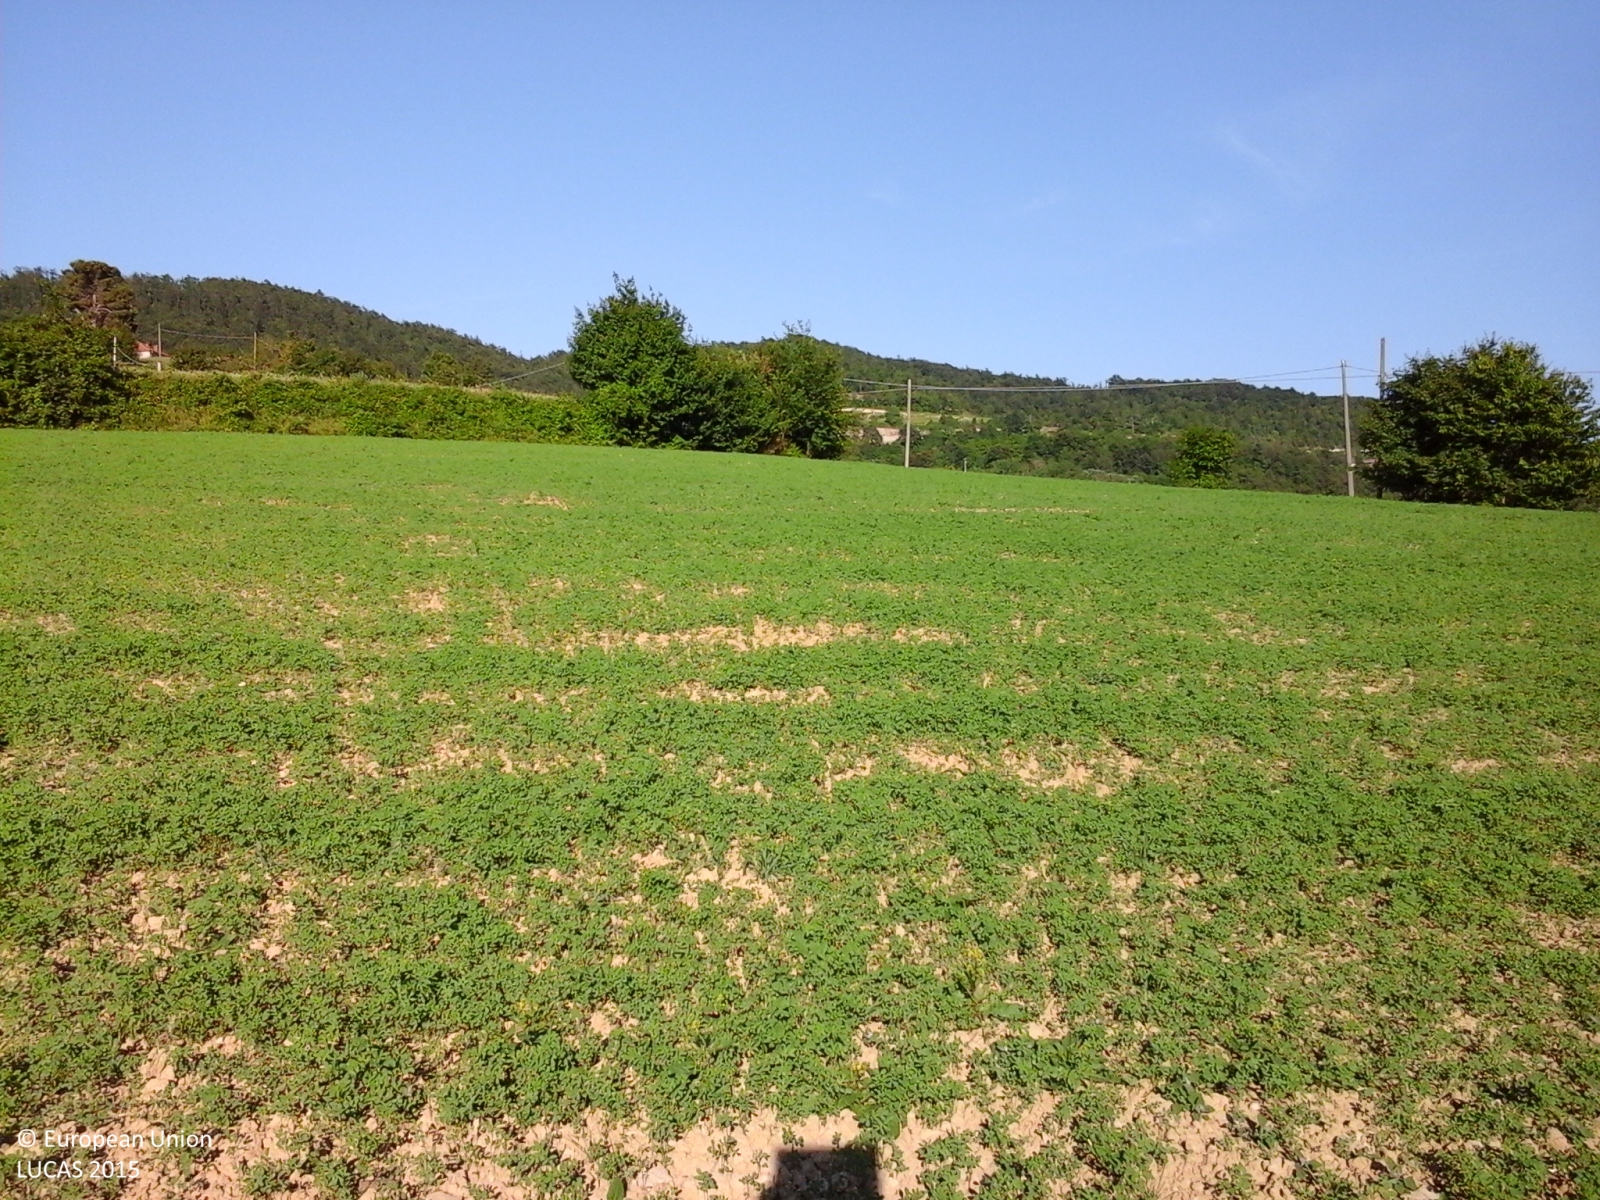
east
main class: Cropland
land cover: Lucerne
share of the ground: > 75 %
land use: Agriculture (excluding fallow land and kitchen gardens)
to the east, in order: Lucerne; Abandoned hedges; Common wheat; Grass margins; Ditches and canals; Grass margins; Paved roads, cycling and walking lanes; Electric lines; Grass margins; Spontaneously vegetated surfaces; Electric lines; Spontaneously vegetated surfaces; Broadleaved woodland; Tracks; Grassland with sparse tree/shrub cover
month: June
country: IT
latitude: 44.5523
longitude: 8.2539
